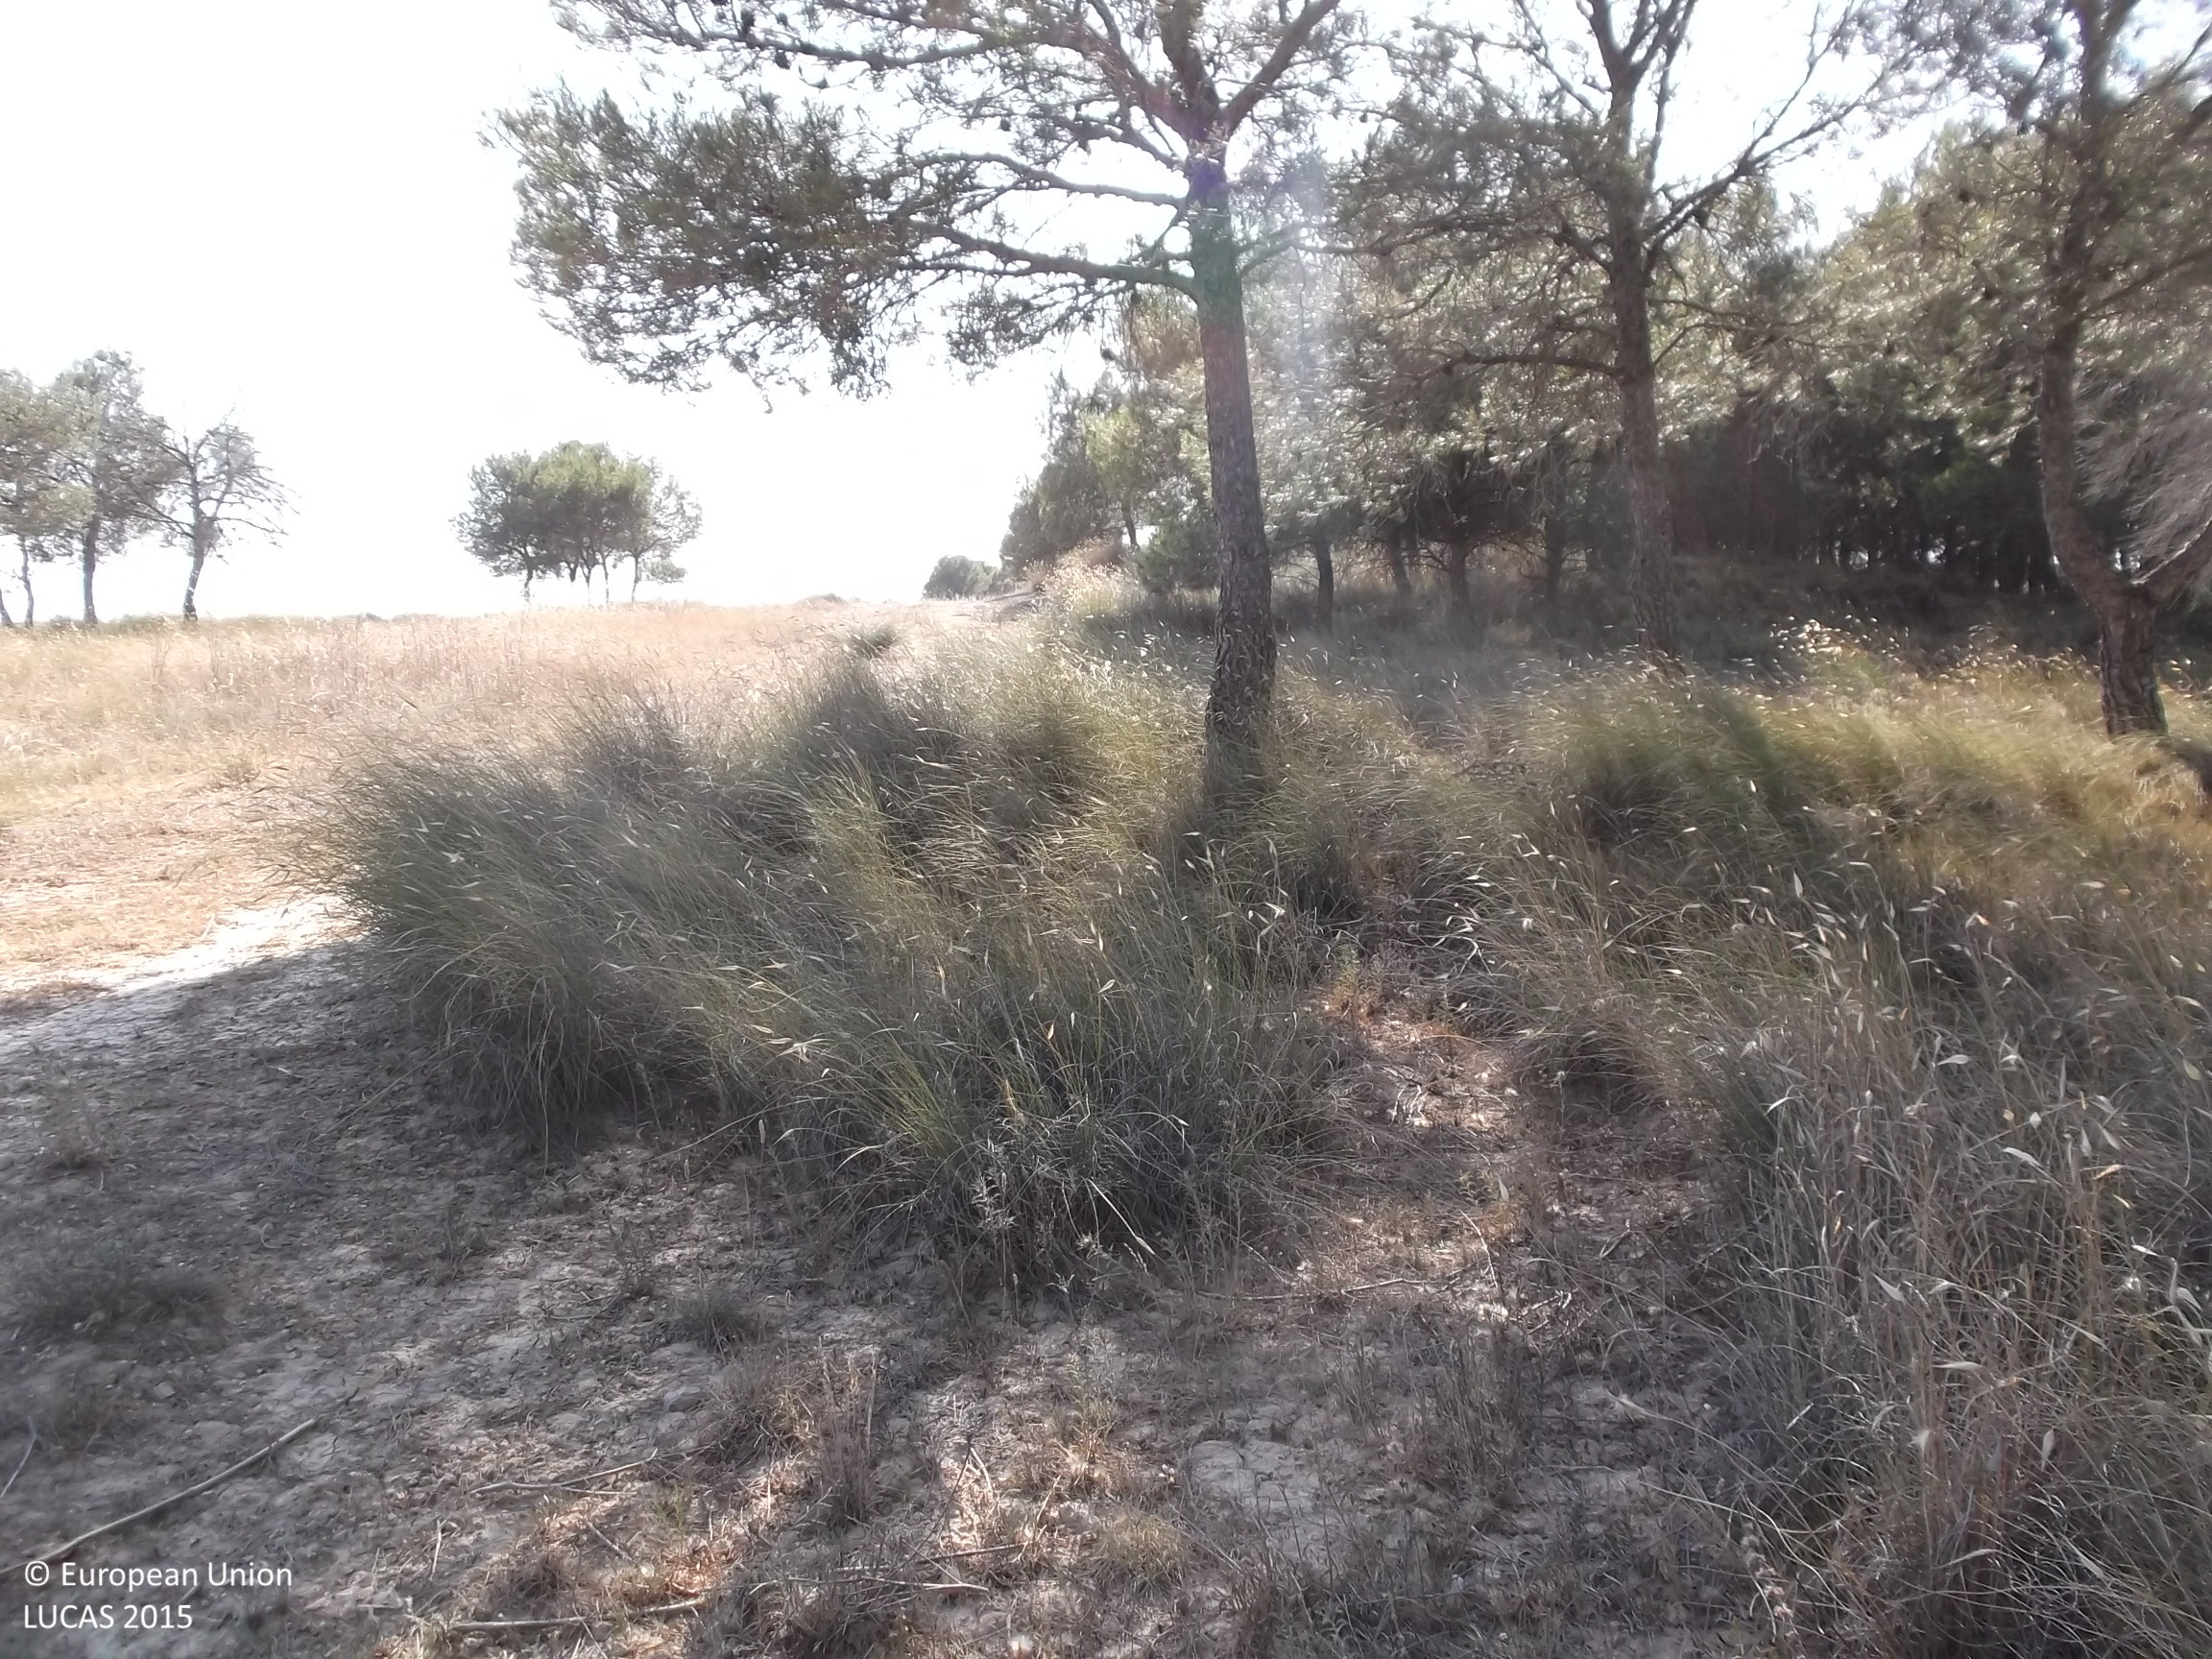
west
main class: Woodland
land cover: Pine dominated coniferous woodland
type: coniferous forest of the mediterranean region
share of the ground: 50 - 75 %
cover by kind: coniferous forest trees 70 %, herbaceous plants 20 %, unconsolidated bare surface 10 %
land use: Semi-natural and natural areas not in use
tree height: < 5 m
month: July
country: ES
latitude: 42.3315
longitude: -1.5999
